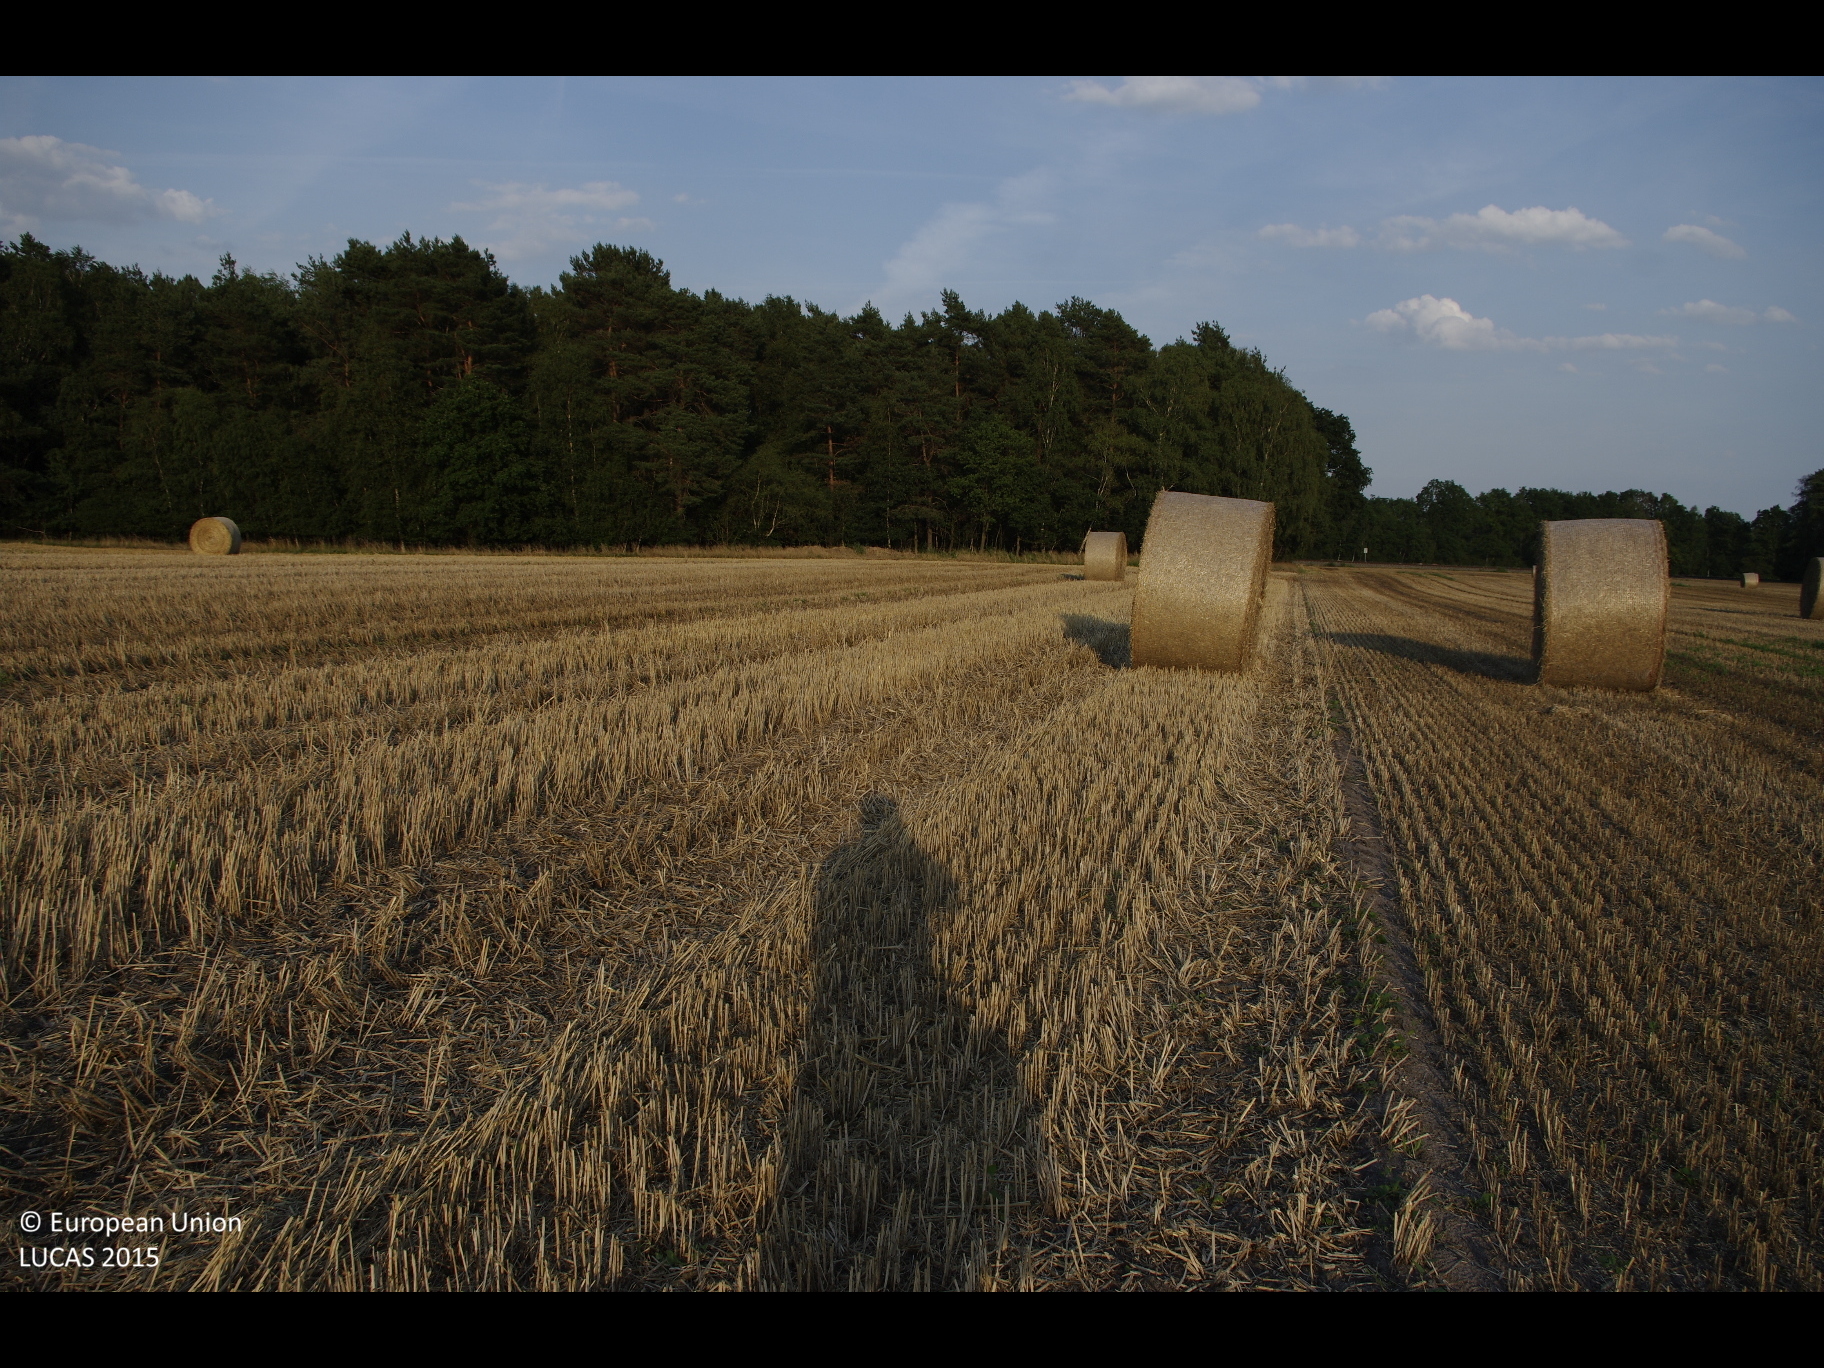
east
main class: Cropland
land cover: Rye
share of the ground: 50 - 75 %
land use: Agriculture (excluding fallow land and kitchen gardens)
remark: Harvested field
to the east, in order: Rye; Pine dominated mixed woodland; Grassland without tree/shrub cover; Tracks; Grass margins; Ditches and canals; Grass margins; Railways; Grassland without tree/shrub cover; Pine dominated mixed woodland
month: August
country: DE
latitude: 53.1682
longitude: 9.8355
